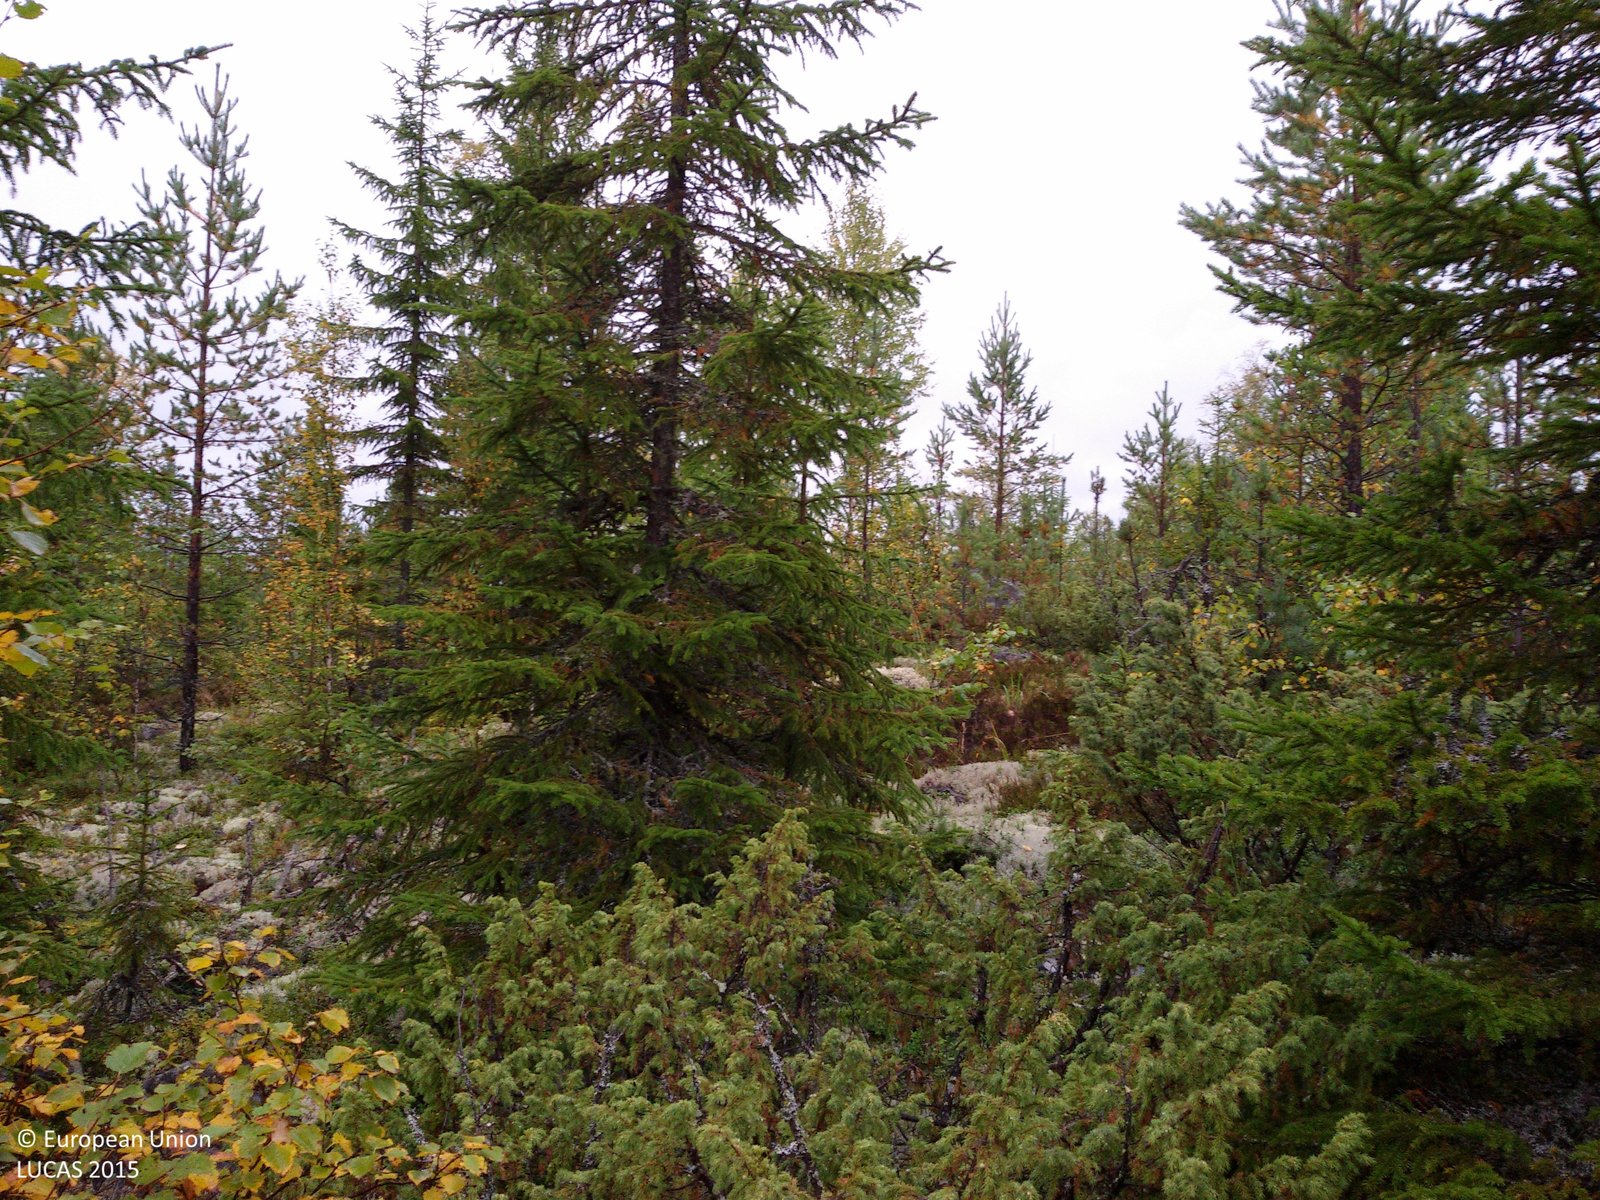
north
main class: Woodland
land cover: Pine dominated mixed woodland
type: boreal forest
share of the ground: 50 - 75 %
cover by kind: coniferous forest trees 40 %, broadleaved forest trees 30 %, lichens and mosses 20 %, herbaceous plants 10 %
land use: Forestry
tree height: > 5 m
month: September
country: SE
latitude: 60.8732
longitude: 14.2787
